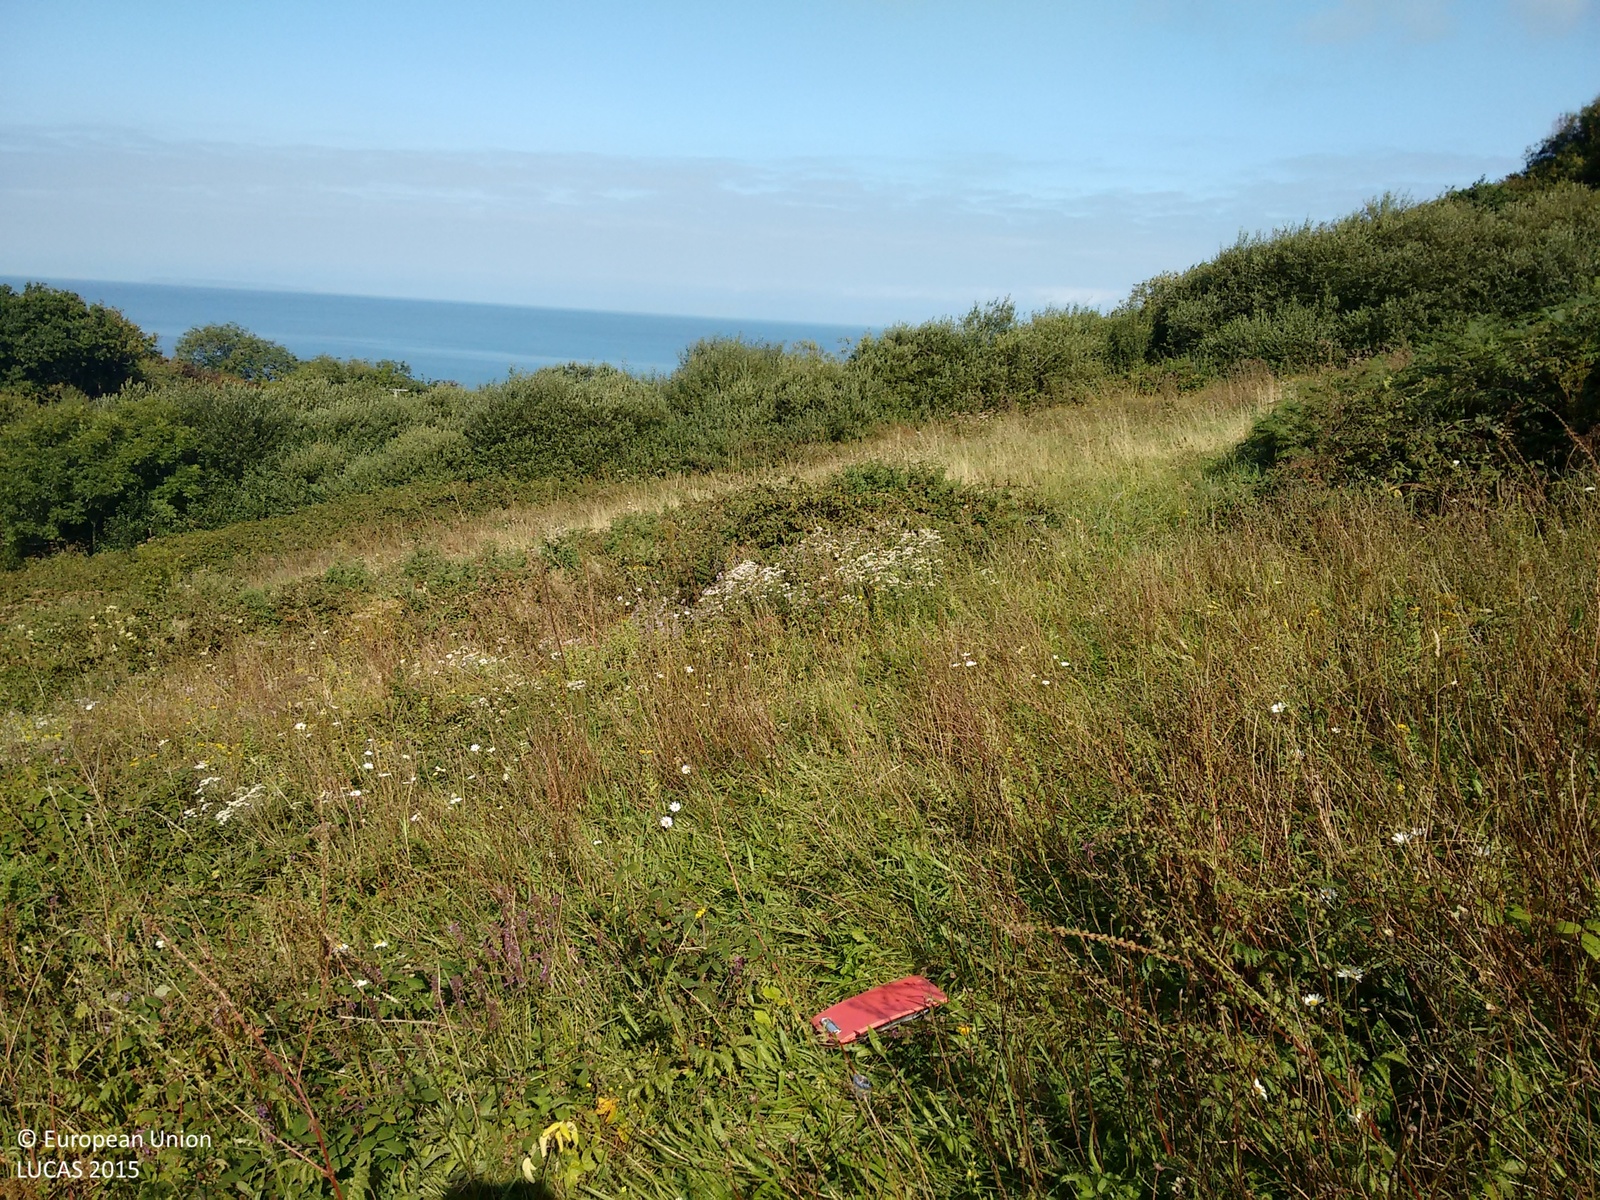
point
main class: Grassland
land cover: Grassland without tree/shrub cover
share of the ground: > 75 %
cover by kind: herbaceous plants 100 %
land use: Agriculture (excluding fallow land and kitchen gardens)
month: September
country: GB
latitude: 50.9933
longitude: -4.3056
